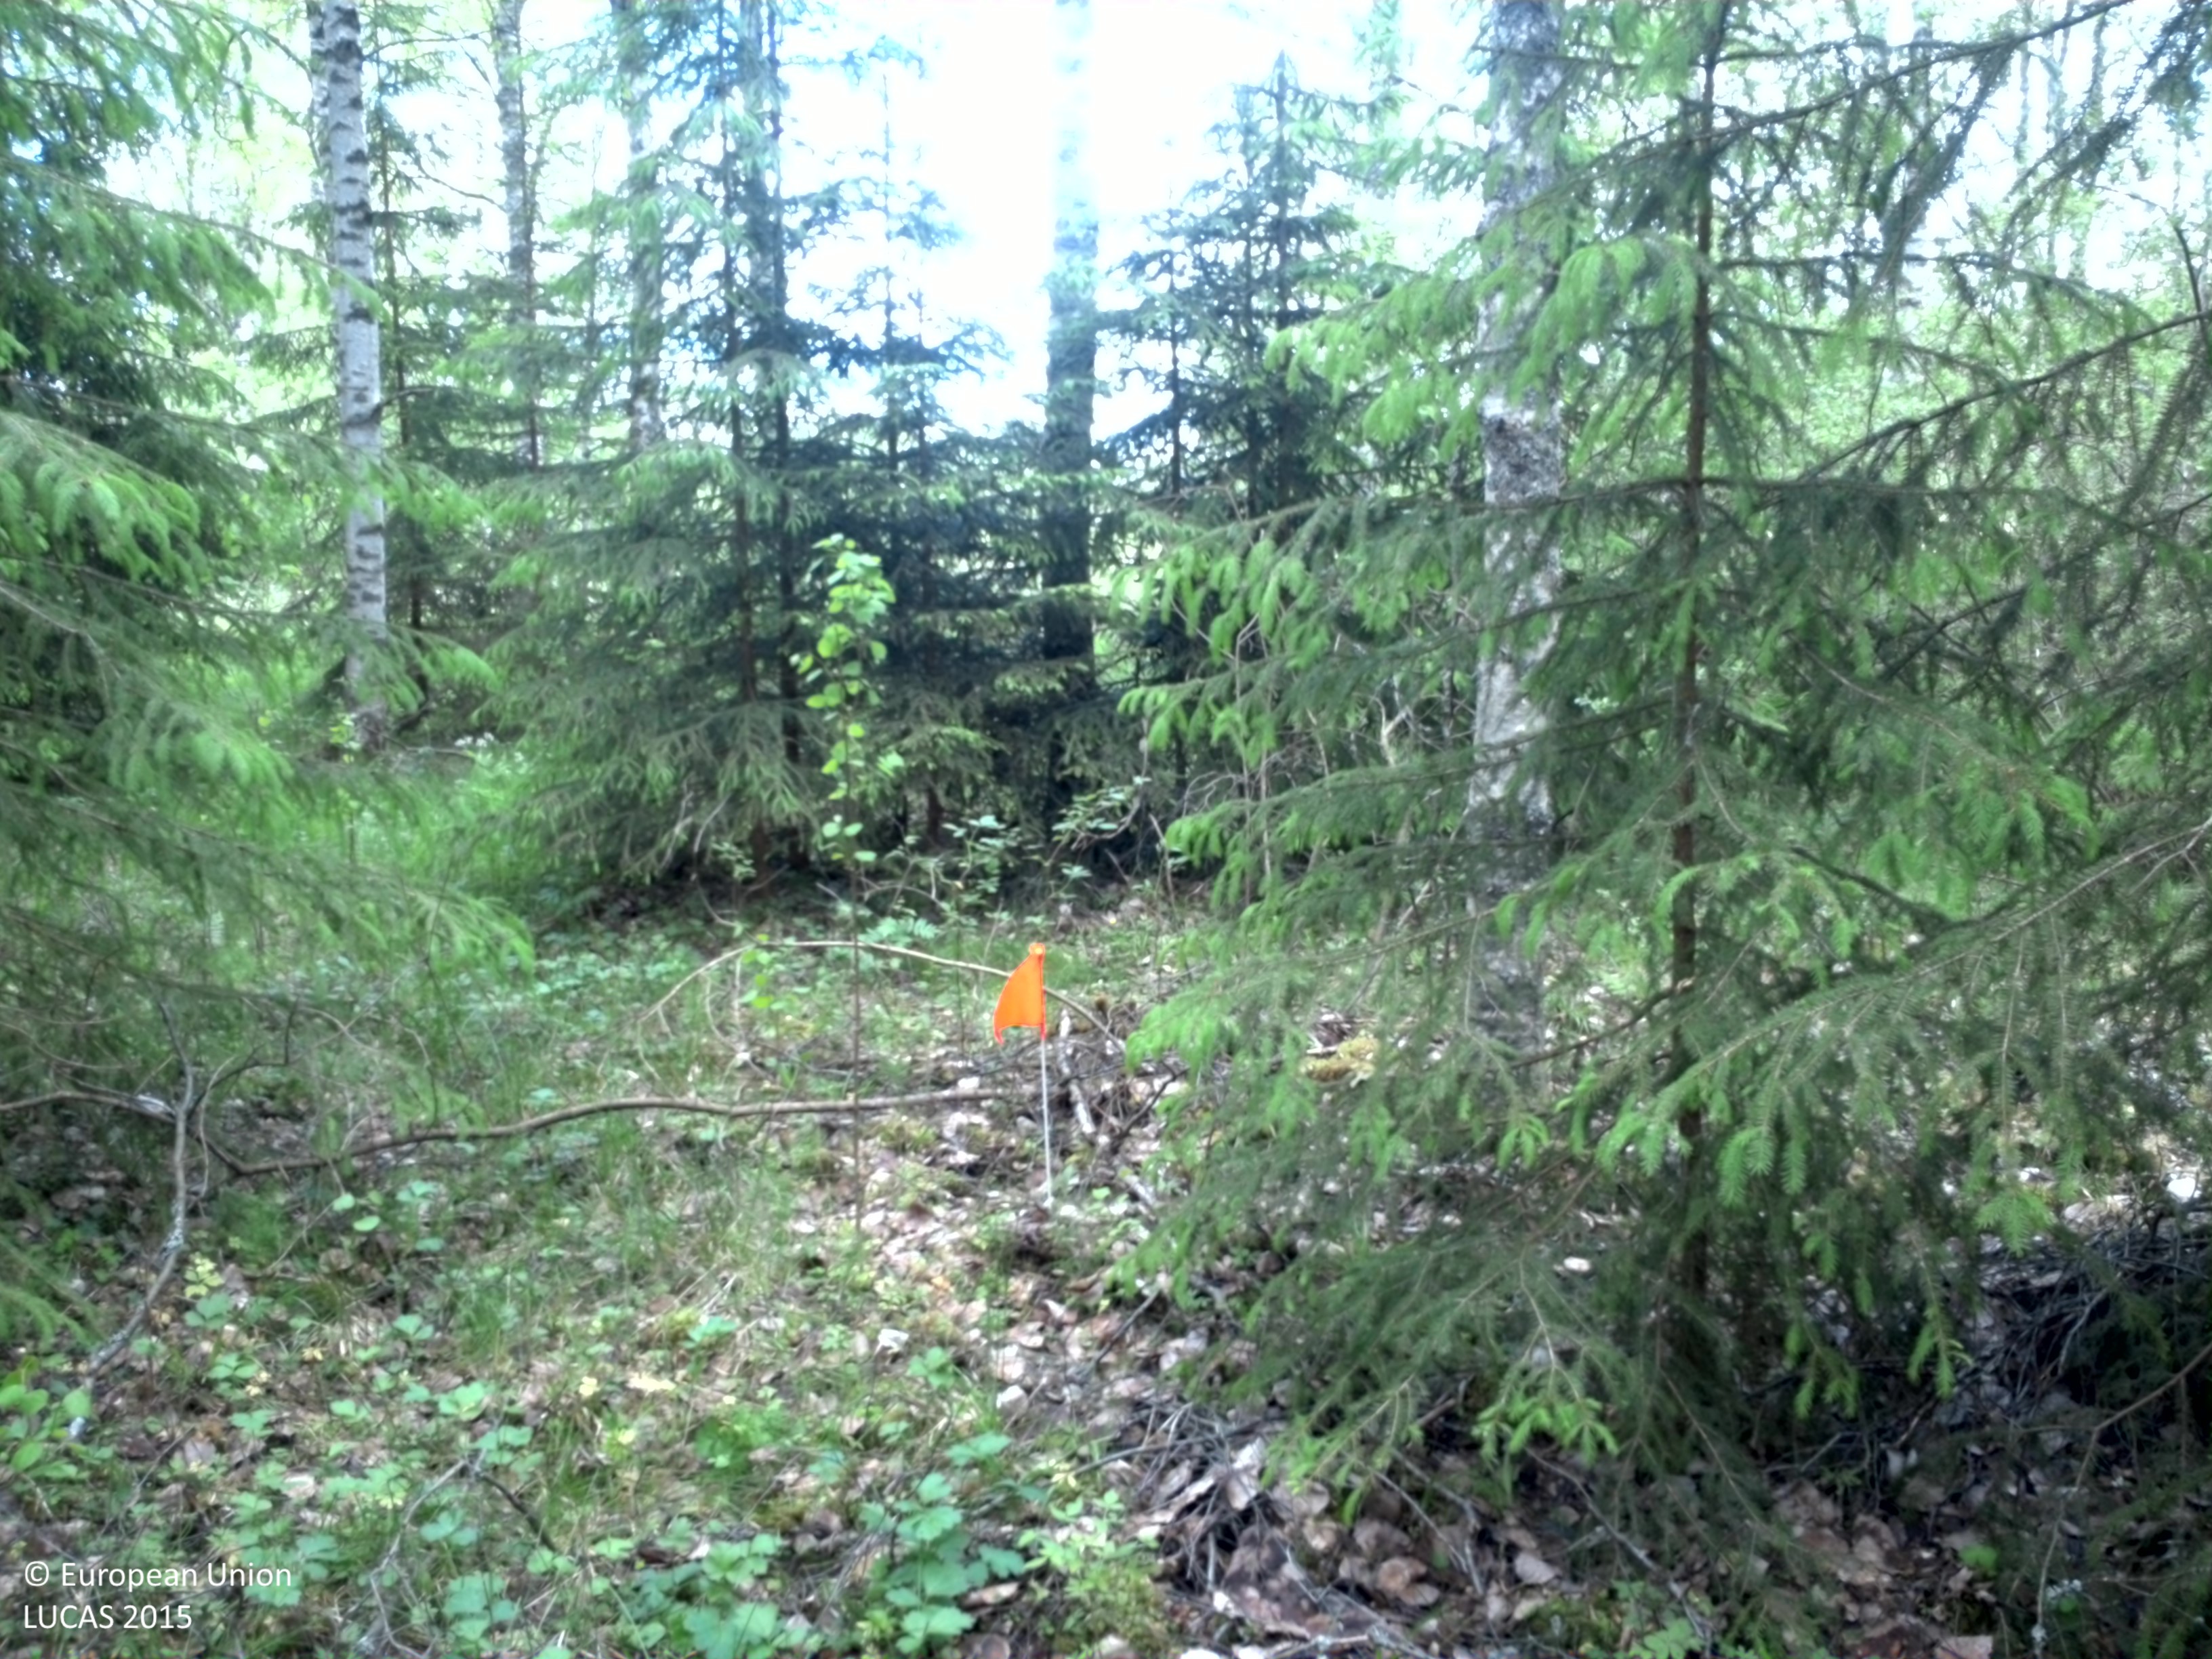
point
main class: Woodland
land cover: Spruce dominated mixed woodland
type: boreal forest
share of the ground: 50 - 75 %
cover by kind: broadleaved forest trees 50 %, coniferous forest trees 20 %, shrubs 15 %, herbaceous plants 15 %
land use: Forestry
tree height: > 5 m
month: June
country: SE
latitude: 59.5239
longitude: 14.1805
